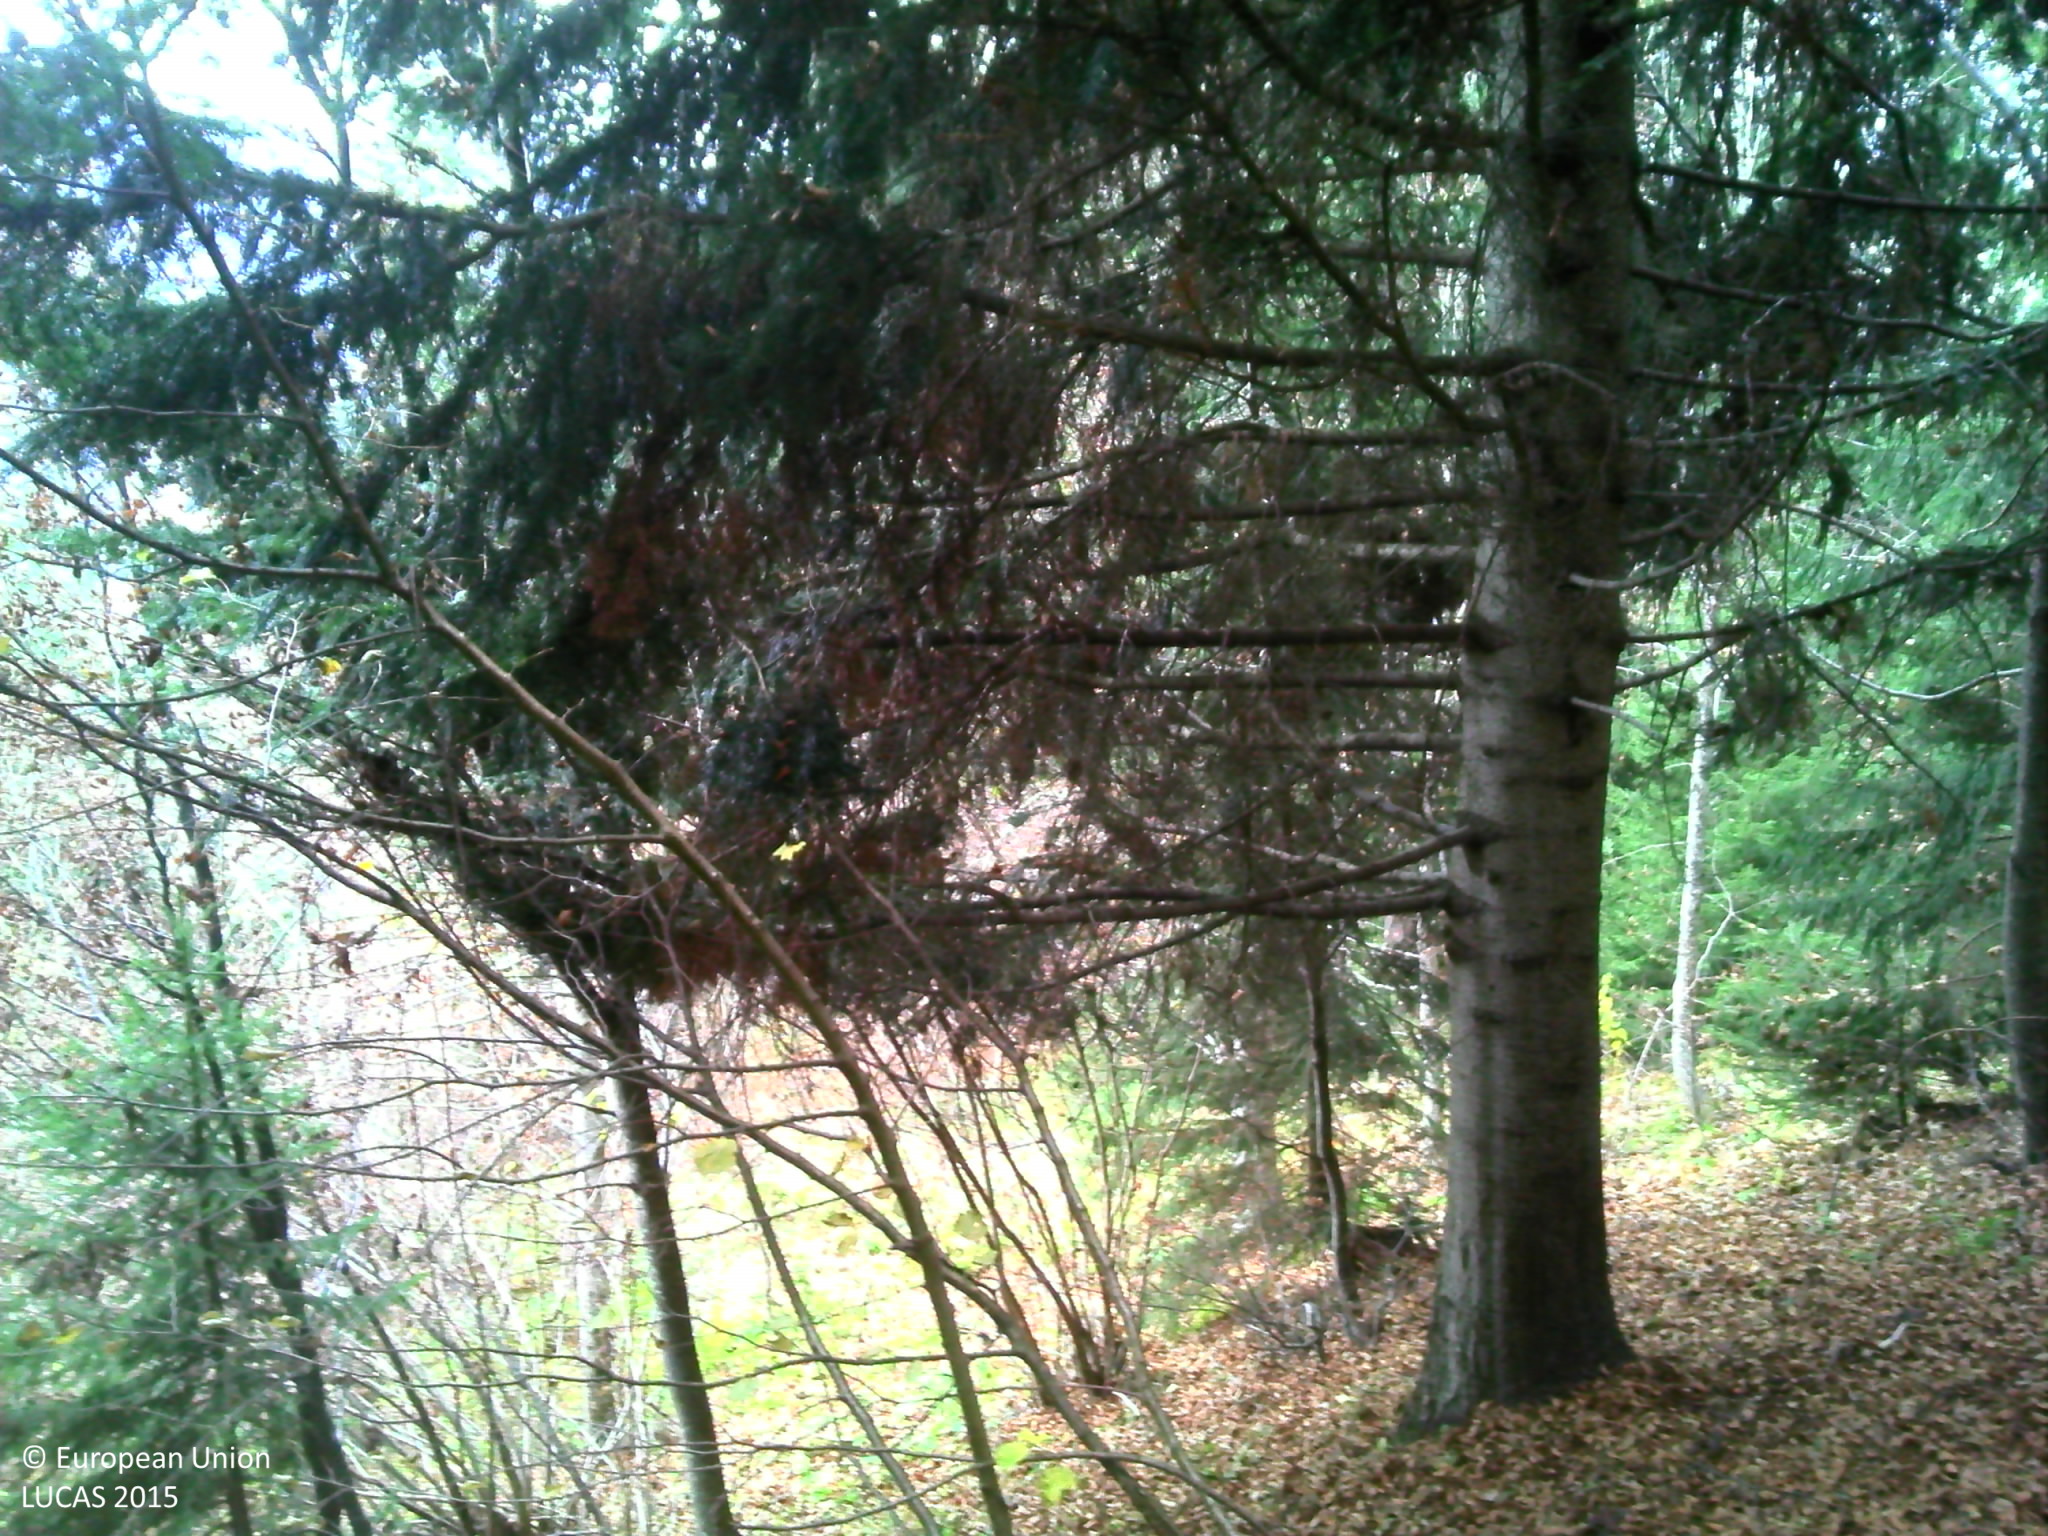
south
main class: Woodland
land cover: Spruce dominated mixed woodland
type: mountainous beech forest
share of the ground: > 75 %
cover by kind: coniferous forest trees 60 %, broadleaved forest trees 30 %, herbaceous plants 10 %
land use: Forestry
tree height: > 5 m
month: November
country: FR
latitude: 45.7880
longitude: 6.4667
